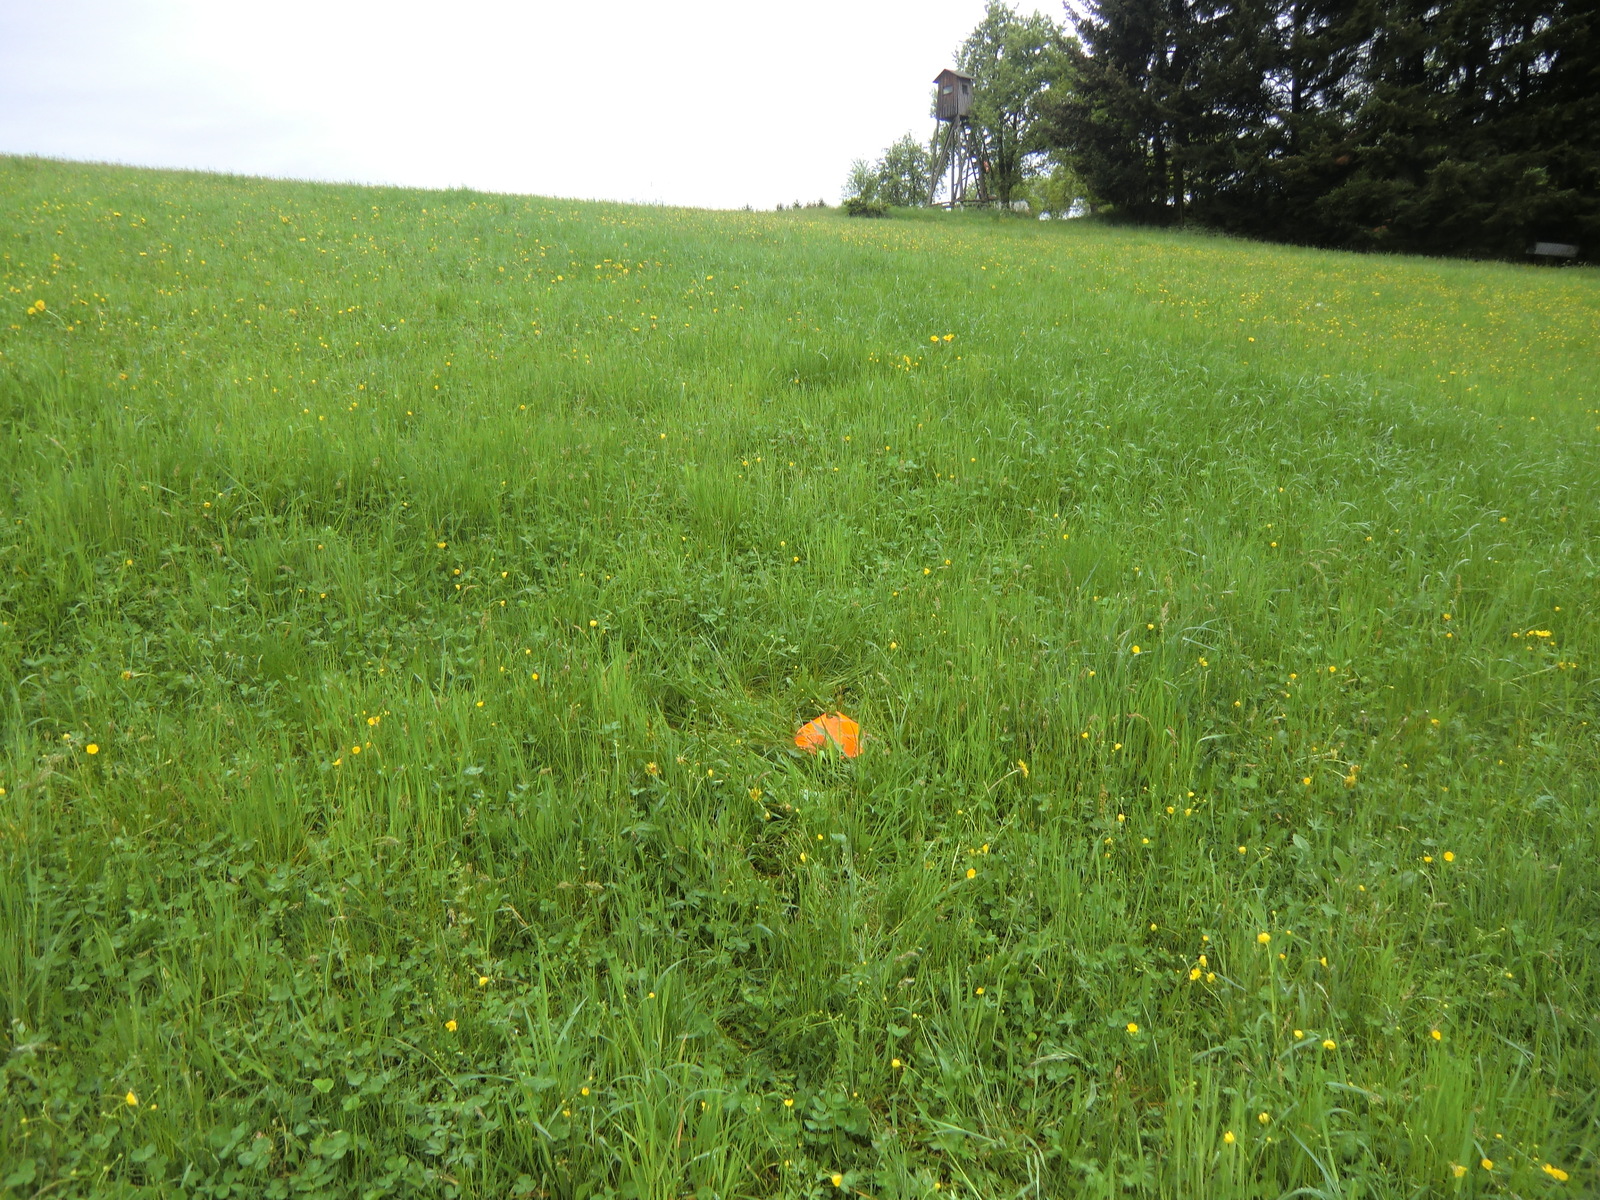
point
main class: Grassland
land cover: Grassland without tree/shrub cover
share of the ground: > 75 %
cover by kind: herbaceous plants 100 %
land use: Agriculture (excluding fallow land and kitchen gardens)
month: May
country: AT
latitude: 48.2854
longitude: 14.7042
